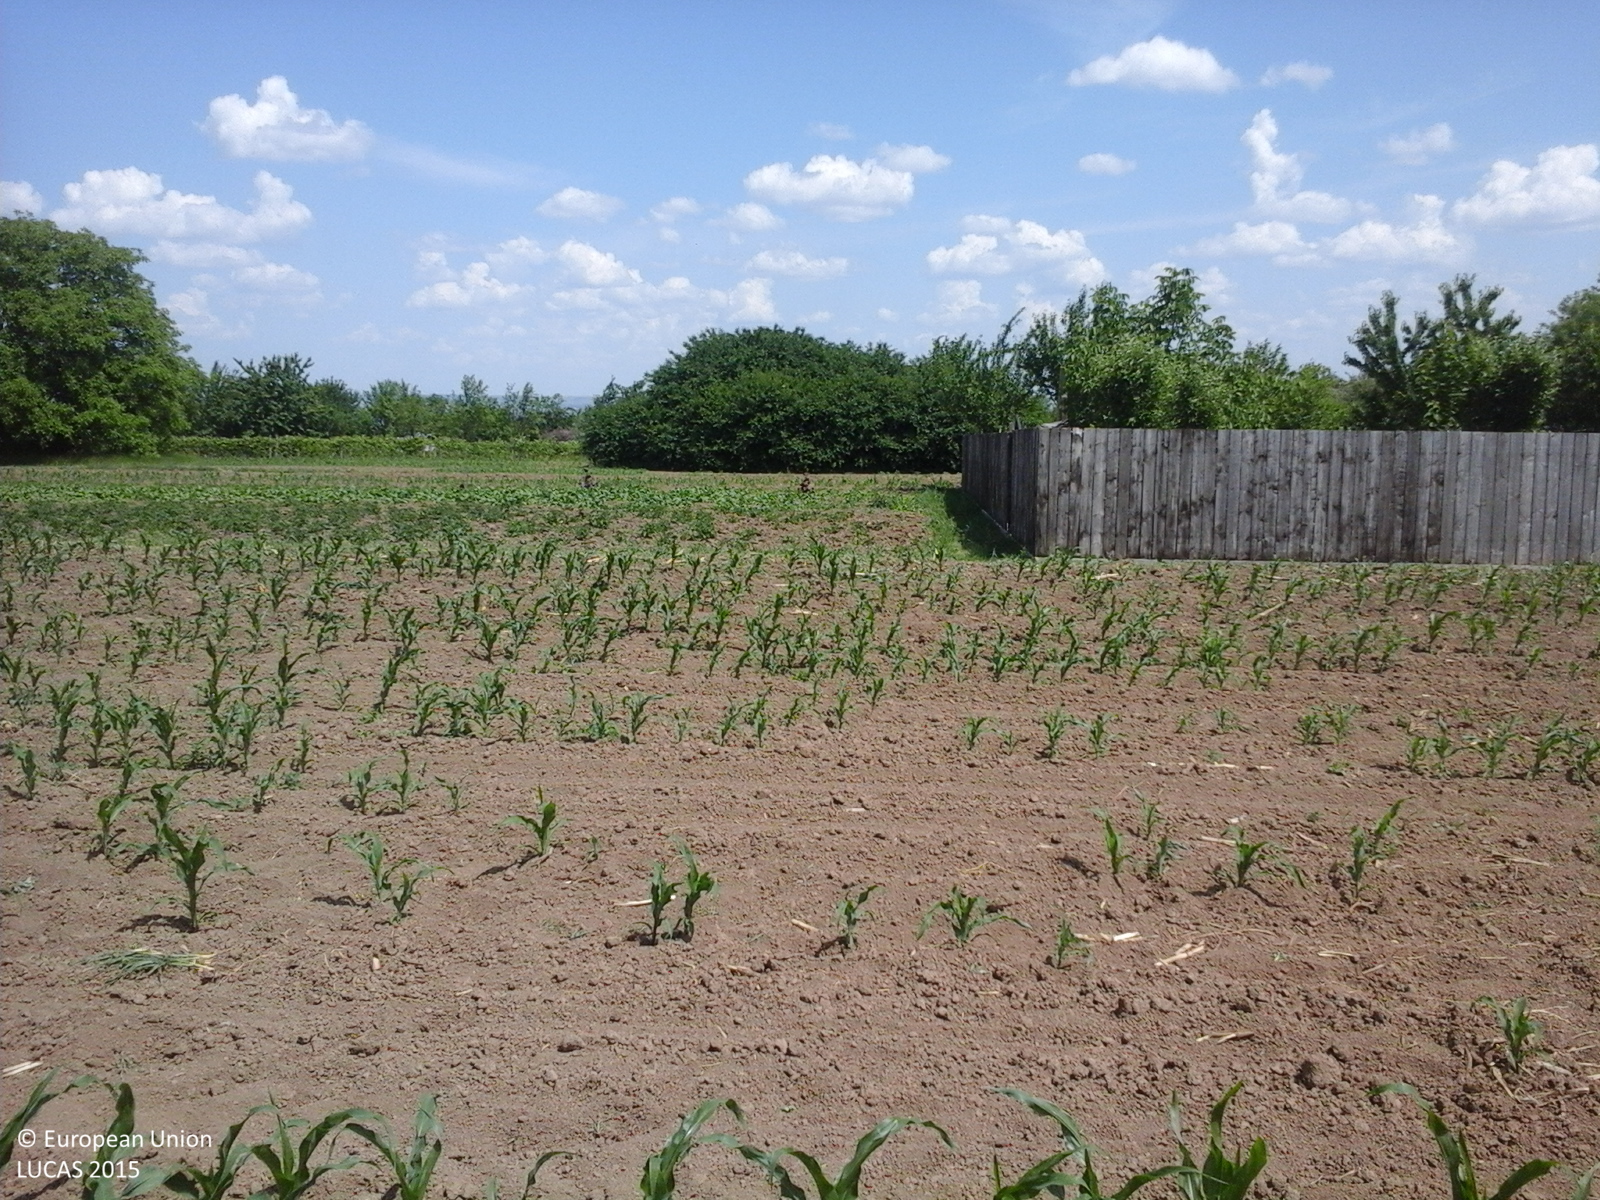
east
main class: Cropland
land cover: Maize
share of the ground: 10 - 25 %
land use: Agriculture (excluding fallow land and kitchen gardens)
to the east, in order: Maize; Potatoes; Fences; Other fresh vegetables; Maize; Tracks; Tomatoes; Cherry fruit; Vineyards; Grass margins; Vineyards; Tracks; Maize; Lucerne
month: June
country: RO
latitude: 46.7938
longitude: 26.7960
